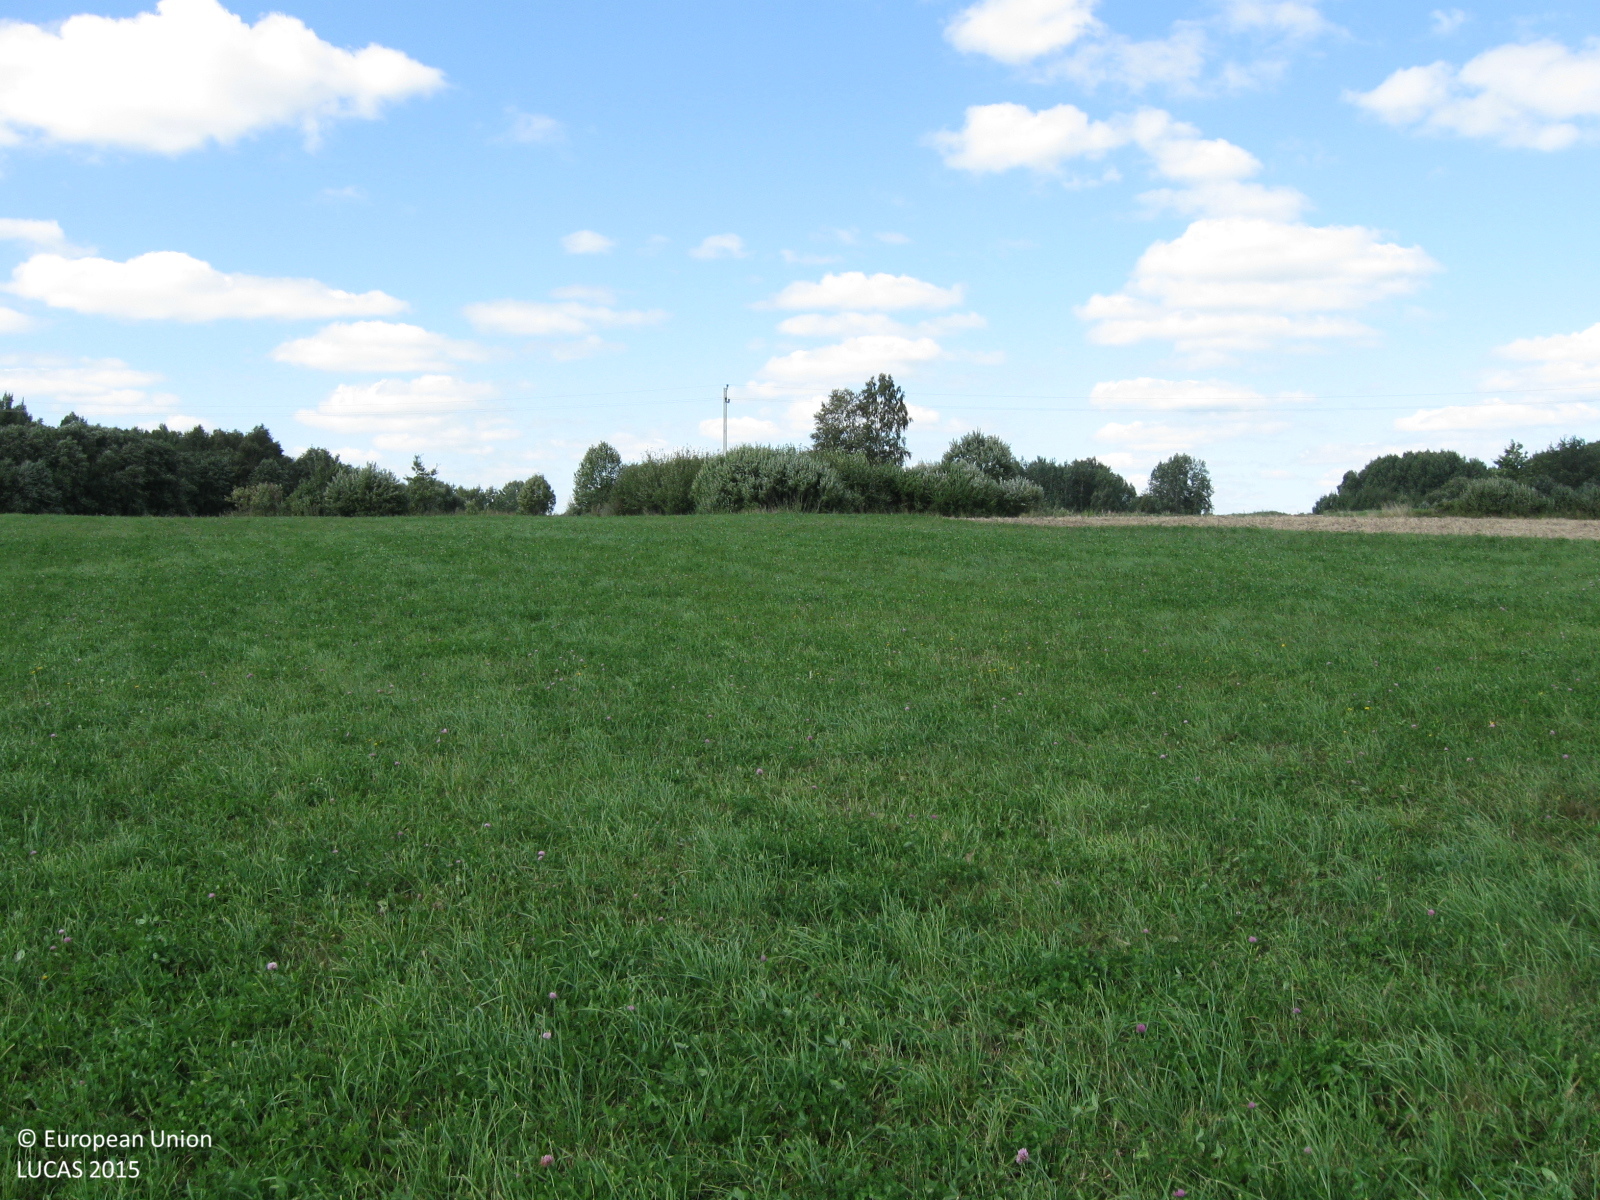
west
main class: Cropland
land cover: Other leguminous and mixtures for fodder
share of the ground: > 75 %
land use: Agriculture (excluding fallow land and kitchen gardens)
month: August
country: LT
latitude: 55.5568
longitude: 22.6672
